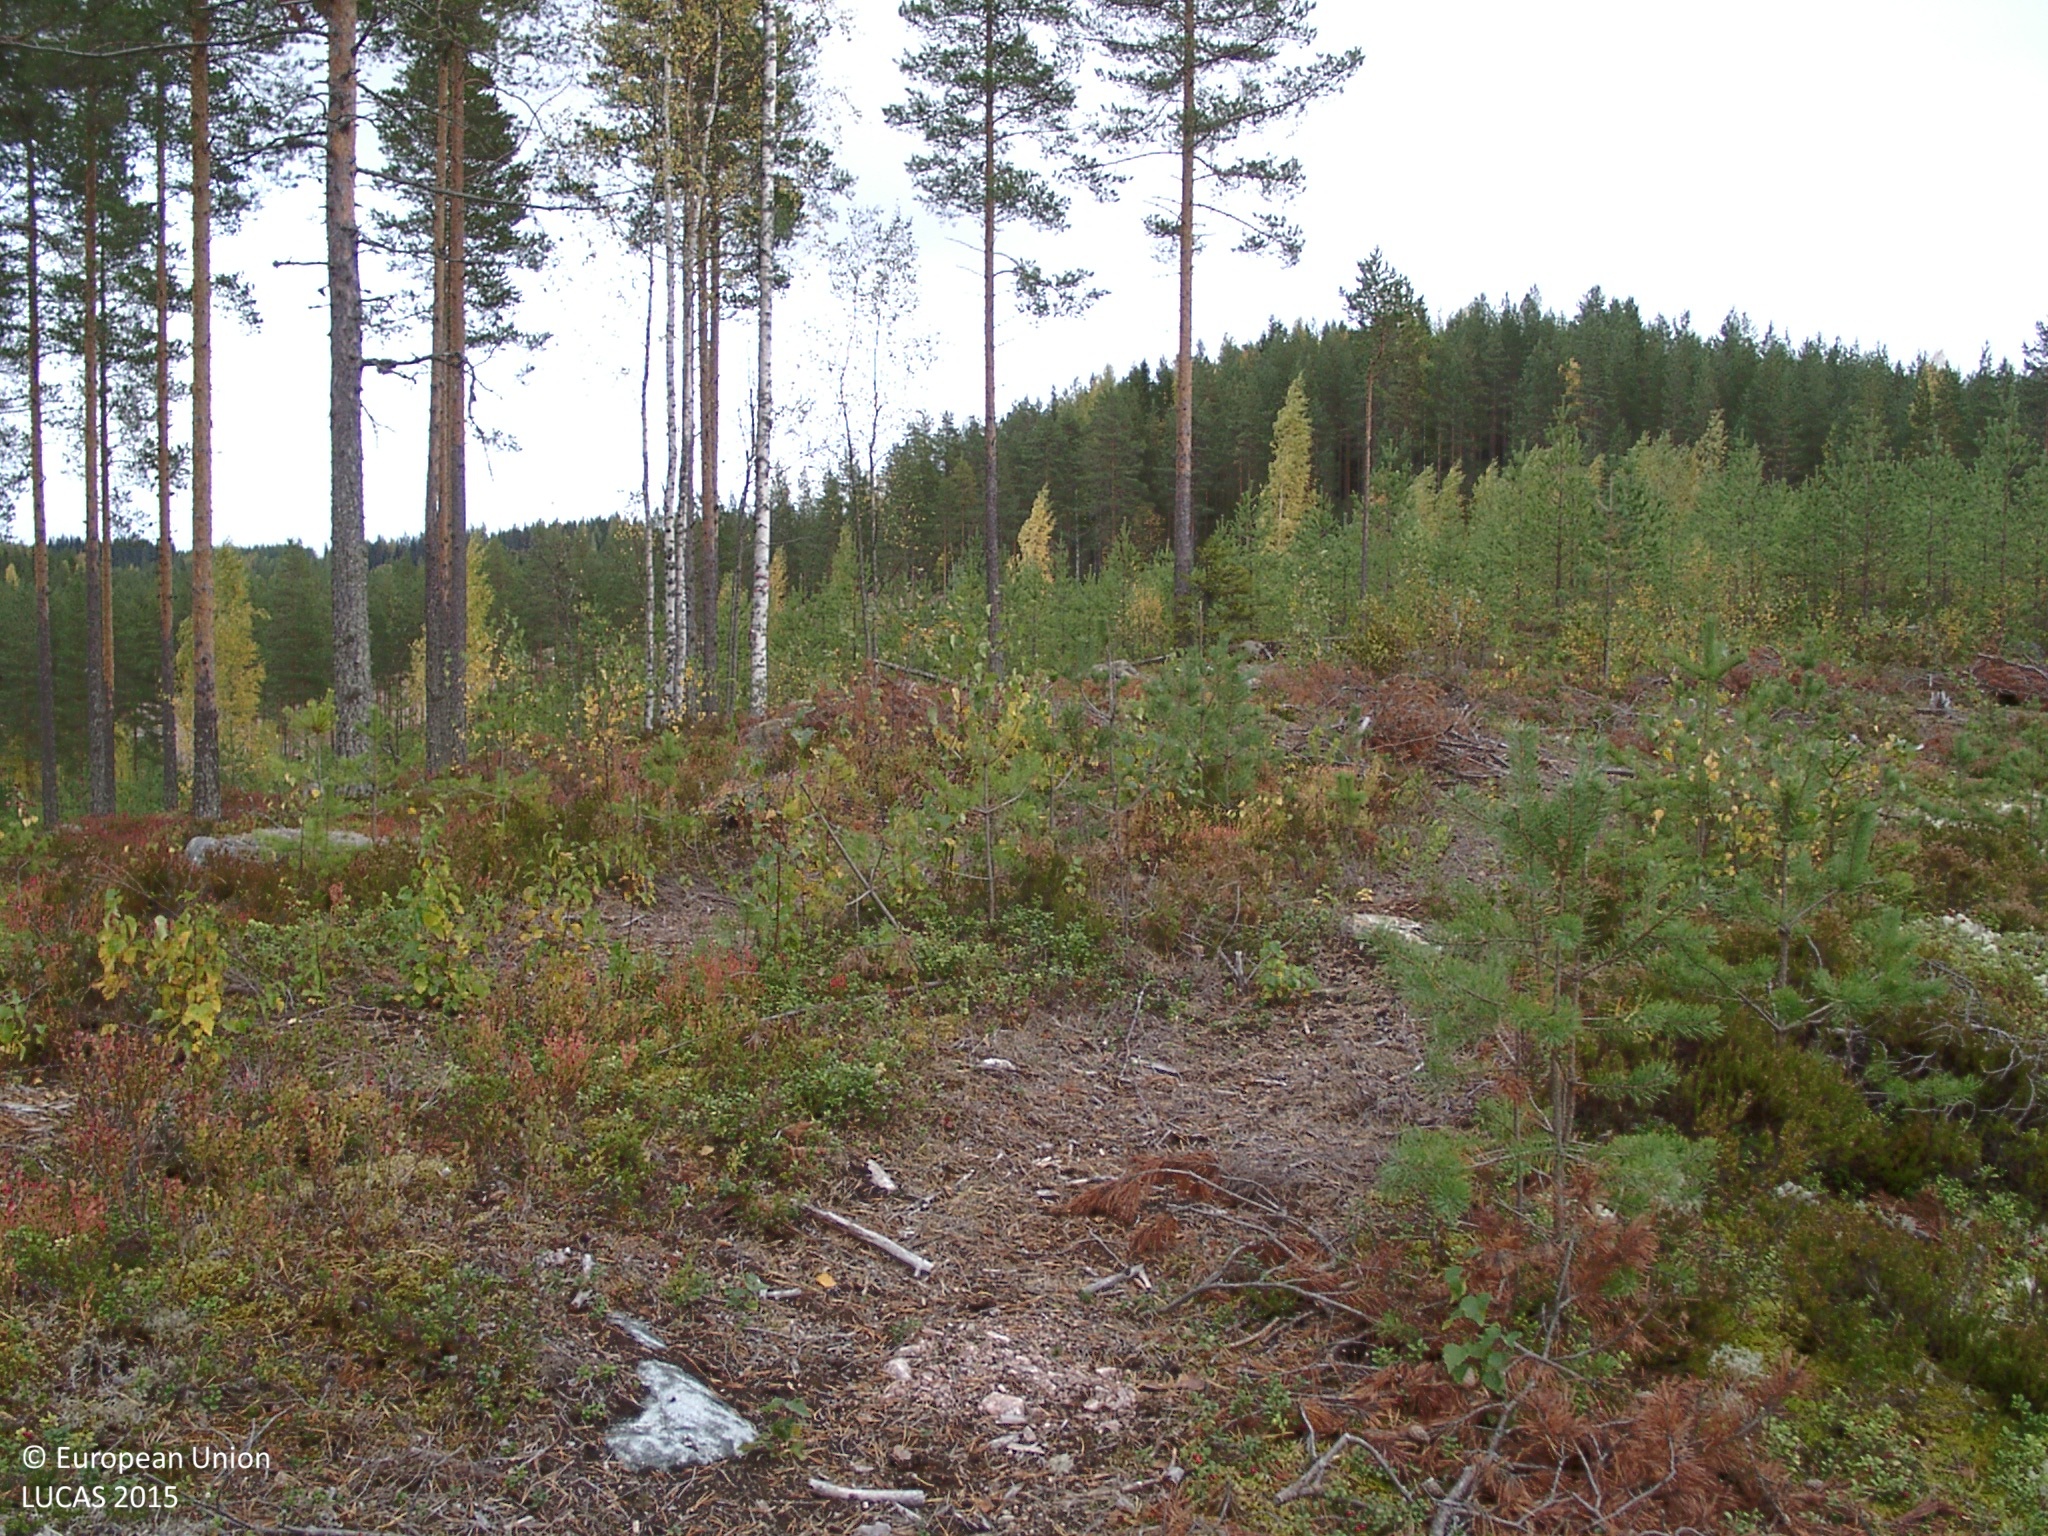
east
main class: Shrubland
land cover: Shrubland with sparse tree cover
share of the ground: 50 - 75 %
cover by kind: shrubs 60 %, lichens and mosses 30 %, coniferous forest trees 5 %
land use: Forestry
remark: Clear cut
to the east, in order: Shrubland with sparse tree cover; Tracks; Pine dominated mixed woodland; Pine dominated coniferous woodland; Shrubland with sparse tree cover; Pine dominated mixed woodland; Pine dominated coniferous woodland; Shrubland with sparse tree cover; Pine dominated coniferous woodland; Tracks; Pine dominated coniferous woodland; Sand
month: September
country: FI
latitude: 62.6019
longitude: 25.4393
